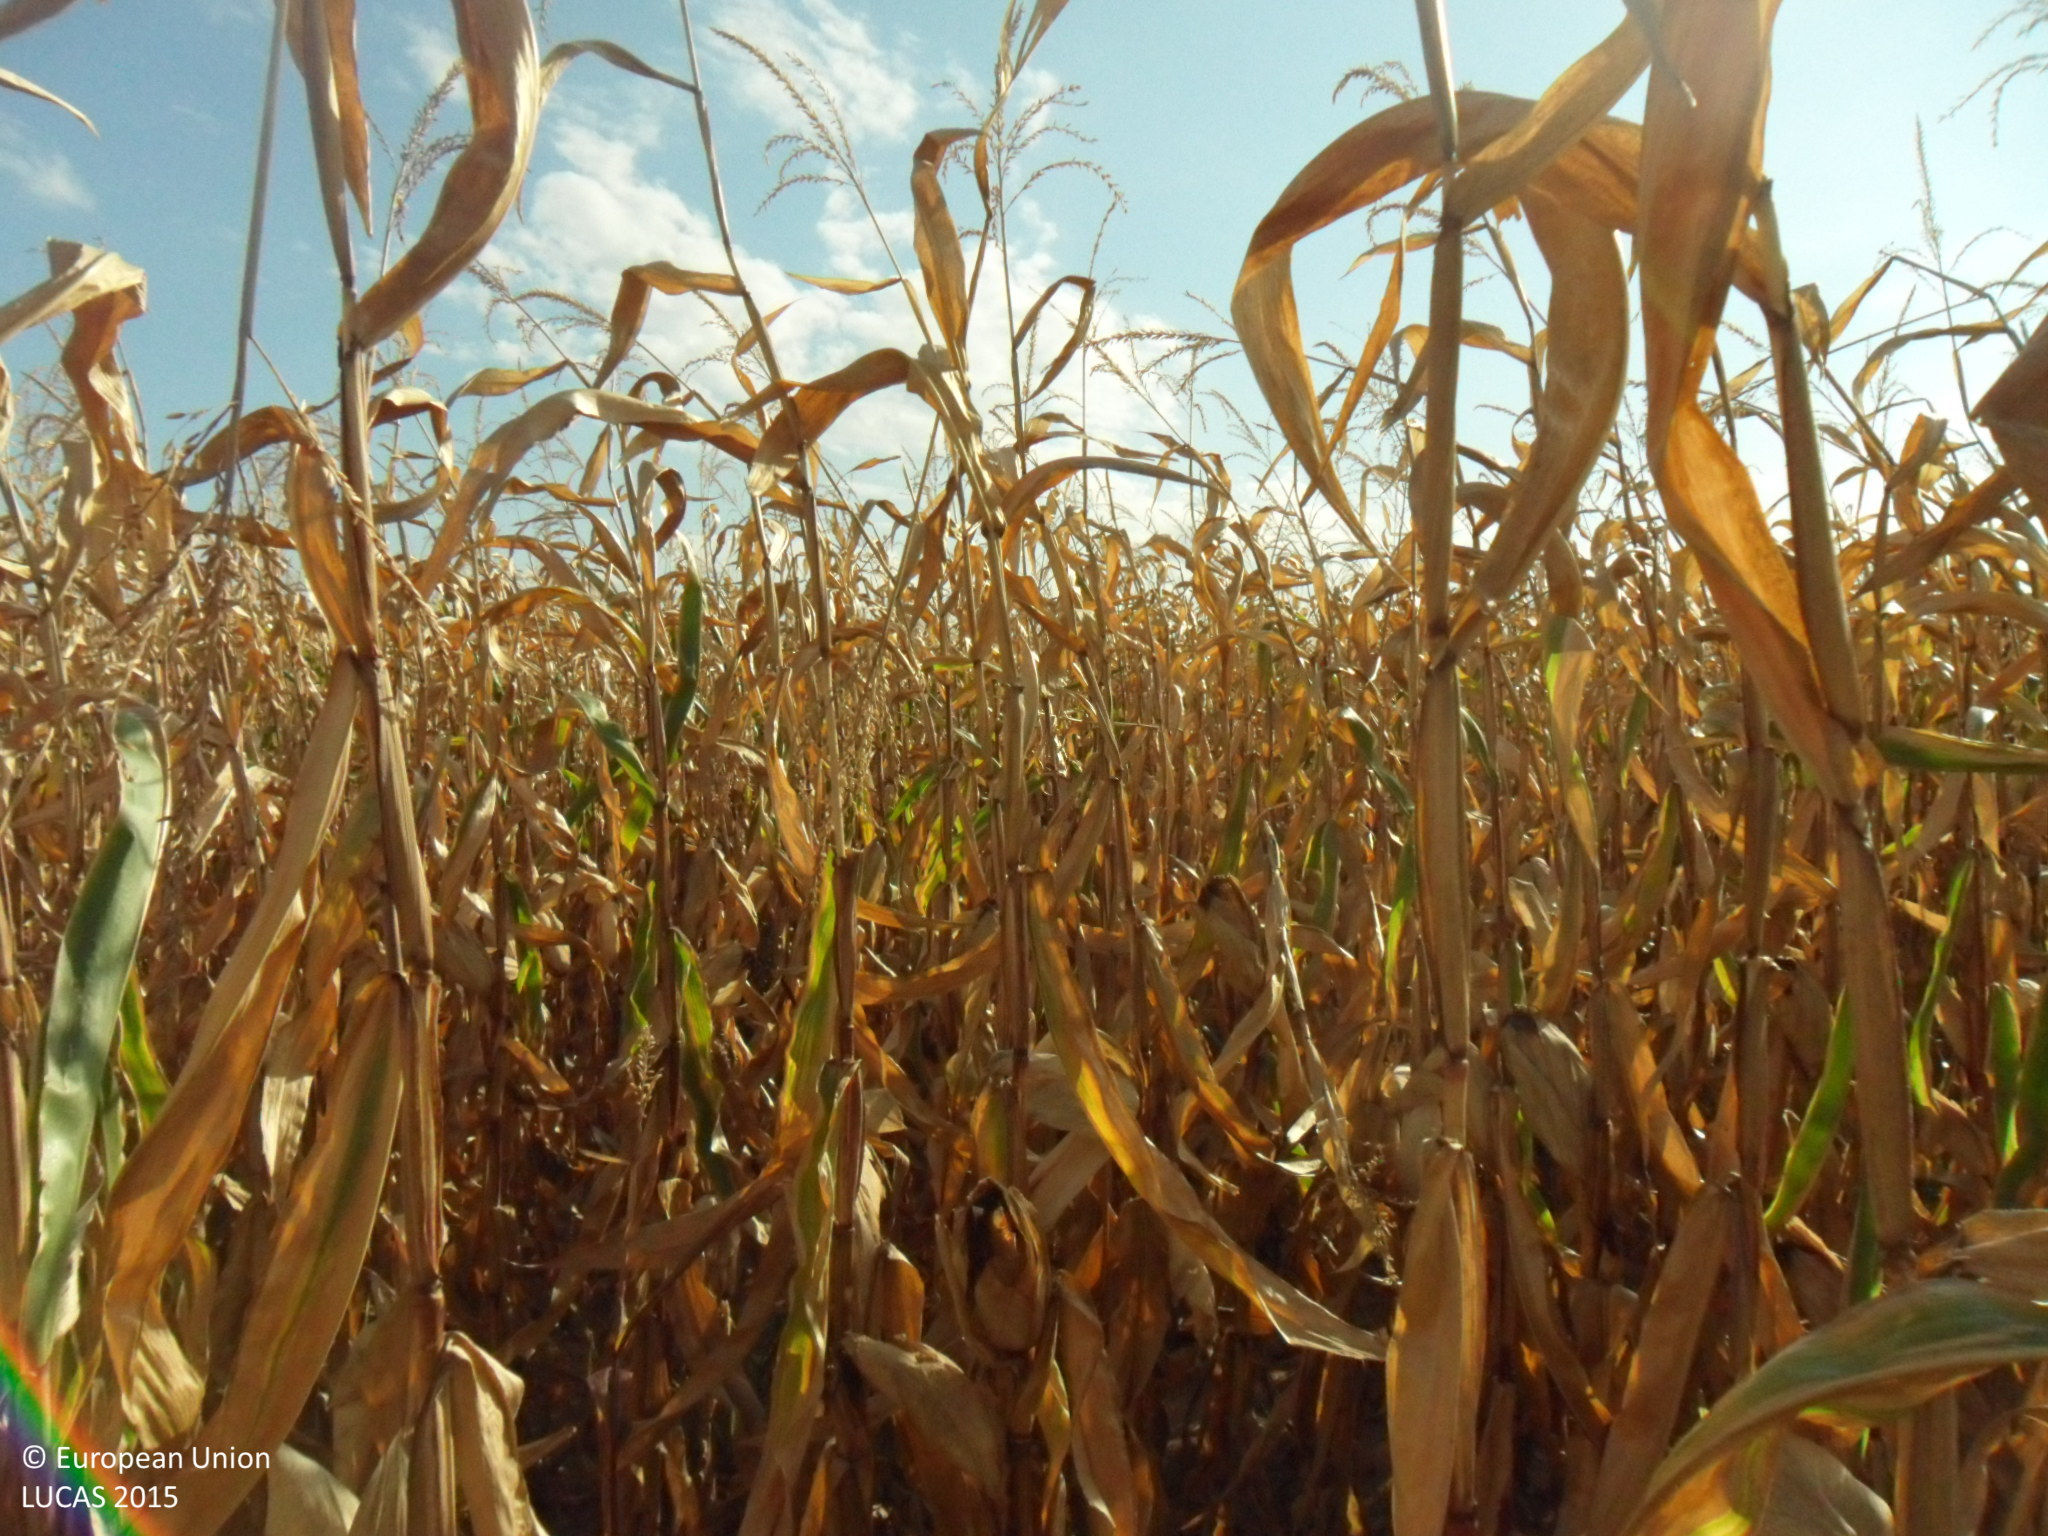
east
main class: Cropland
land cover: Maize
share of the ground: > 75 %
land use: Agriculture (excluding fallow land and kitchen gardens)
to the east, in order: Maize; Grassland with sparse tree/shrub cover; Maize
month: September
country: BG
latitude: 43.5958
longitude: 26.3413
